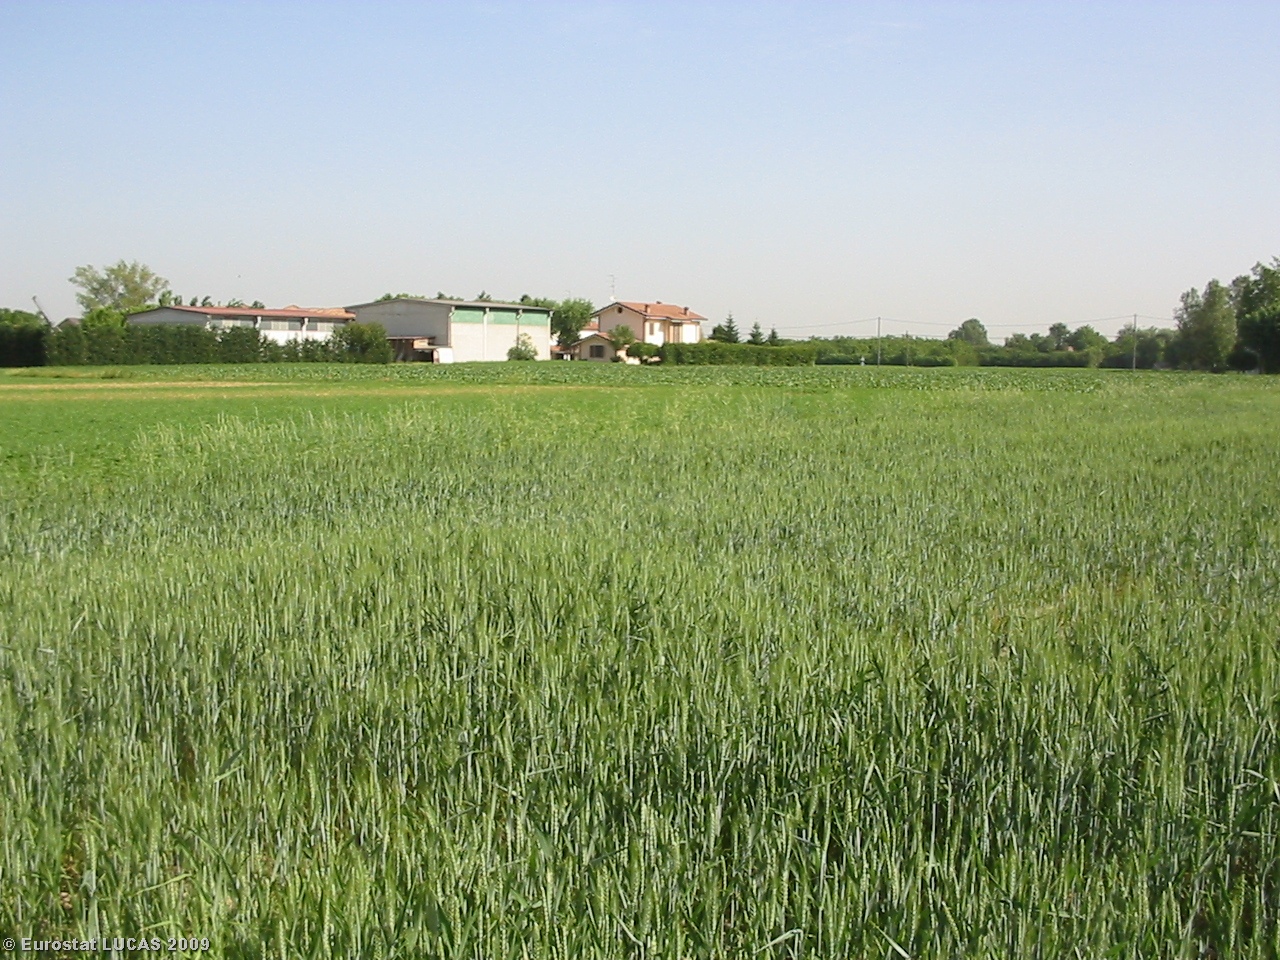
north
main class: Cropland
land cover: Common wheat
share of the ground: > 75 %
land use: Agriculture (excluding fallow land and kitchen gardens)
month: May
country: IT
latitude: 44.8545
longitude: 10.4420
